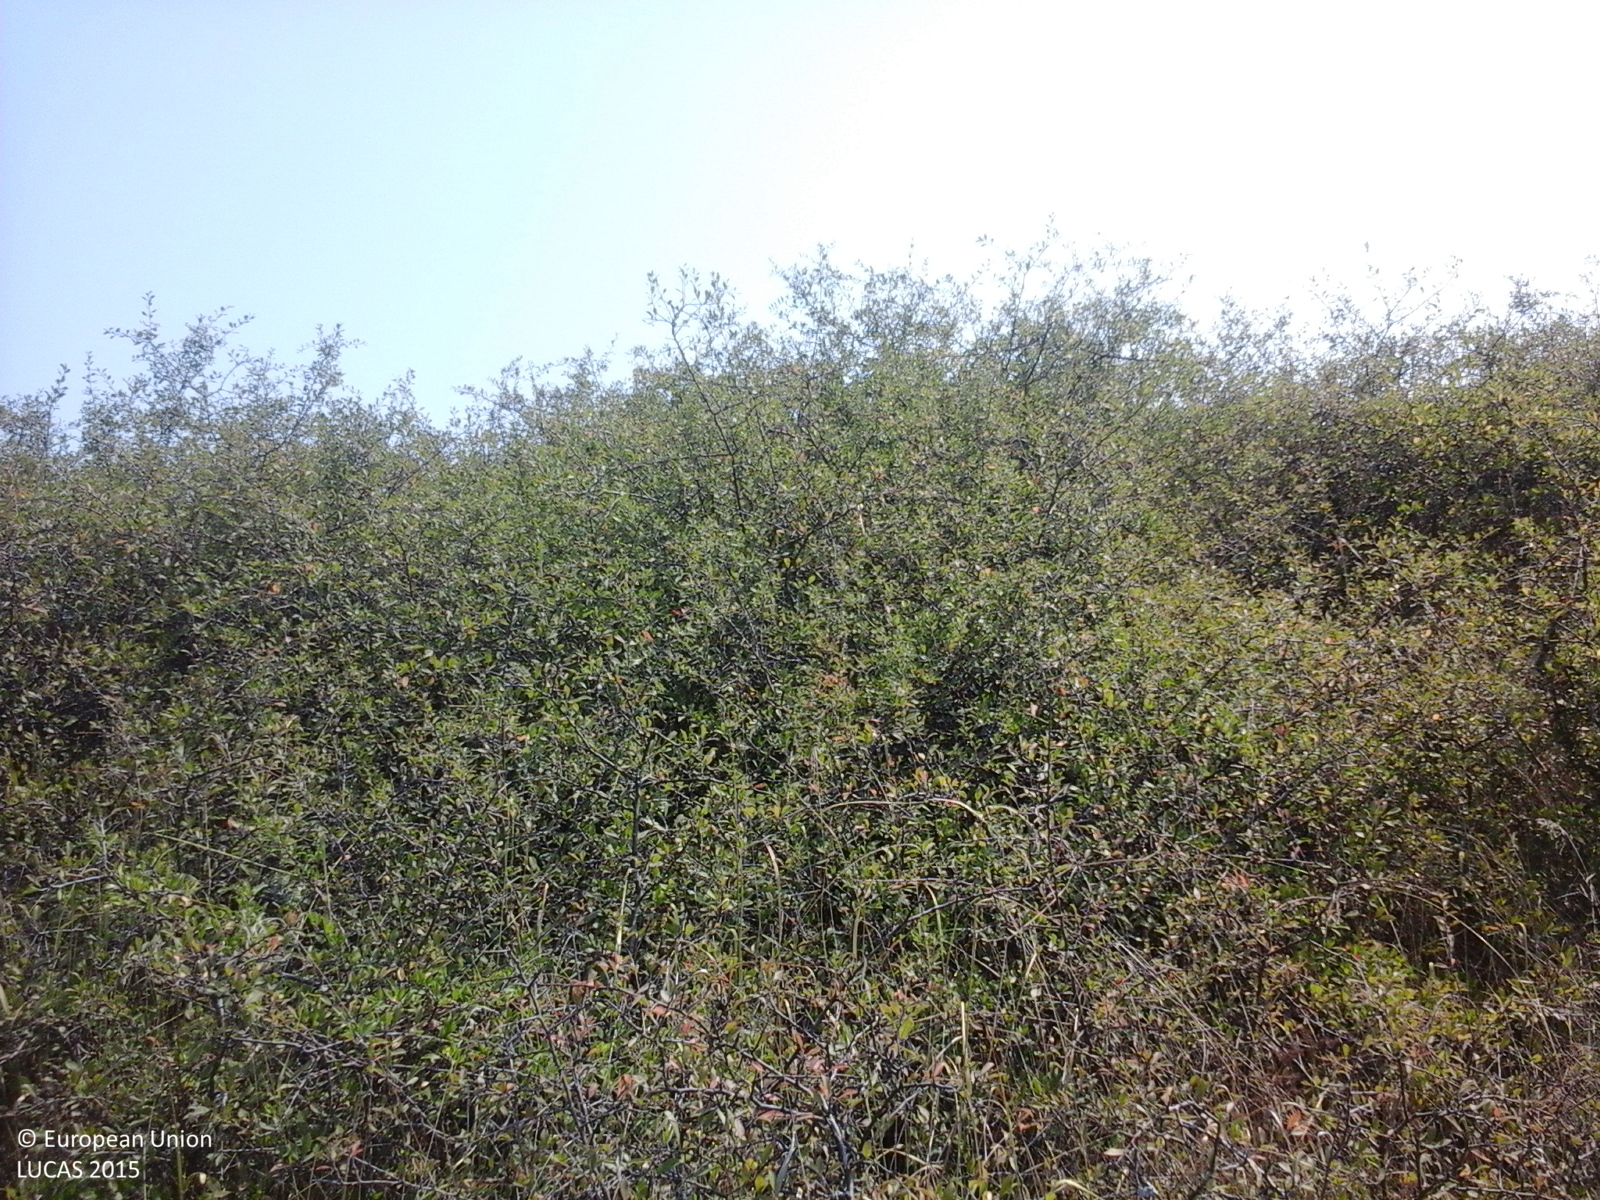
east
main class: Shrubland
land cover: Shrubland without tree cover
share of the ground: > 75 %
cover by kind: shrubs 90 %, herbaceous plants 10 %
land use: Agriculture (excluding fallow land and kitchen gardens)
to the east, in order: Shrubland without tree cover; Grassland without tree/shrub cover; Fences; Spontaneously vegetated surfaces
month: August
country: RO
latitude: 44.6446
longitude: 23.6870
